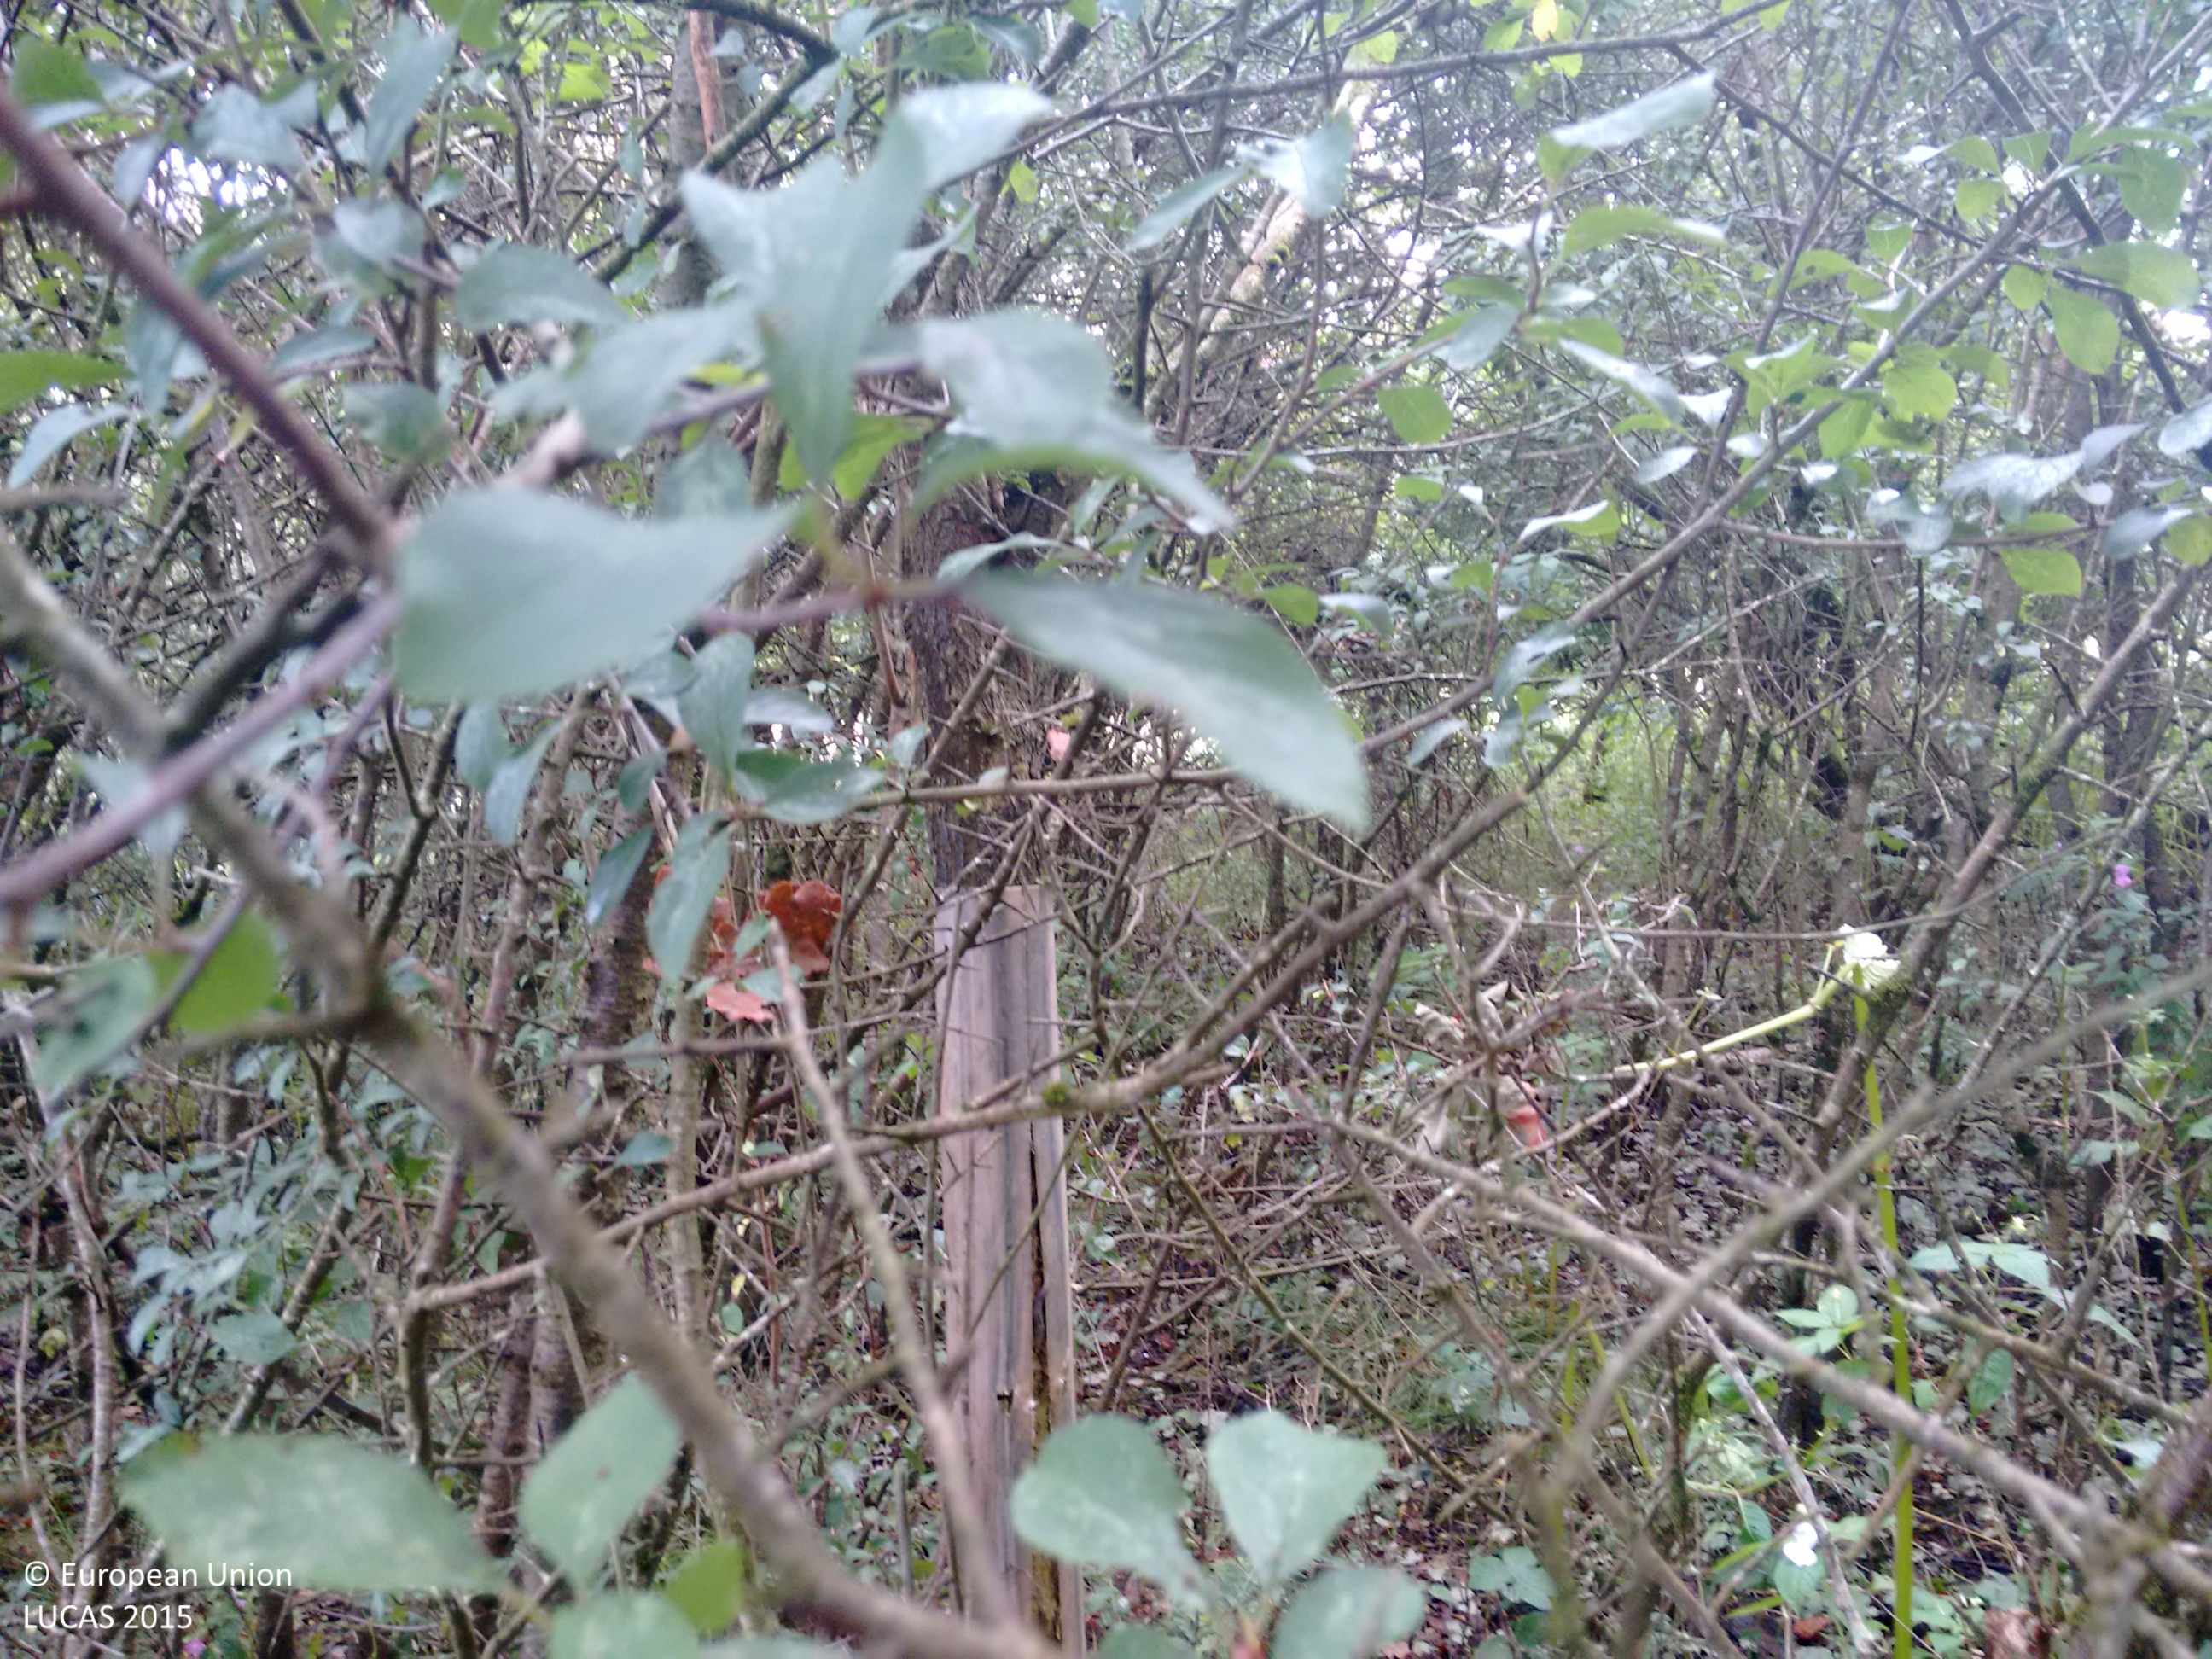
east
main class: Woodland
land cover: Broadleaved woodland
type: mesophytic deciduous forest
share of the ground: > 75 %
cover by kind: broadleaved forest trees 100 %
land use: Semi-natural and natural areas not in use
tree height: > 5 m
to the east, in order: Broadleaved woodland; Fences; Tracks; Broadleaved woodland; Inland fresh running water; Broadleaved woodland; Grassland without tree/shrub cover; Broadleaved woodland; Arable land (only in case pi)
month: September
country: GB
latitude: 50.7613
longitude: -4.4072
